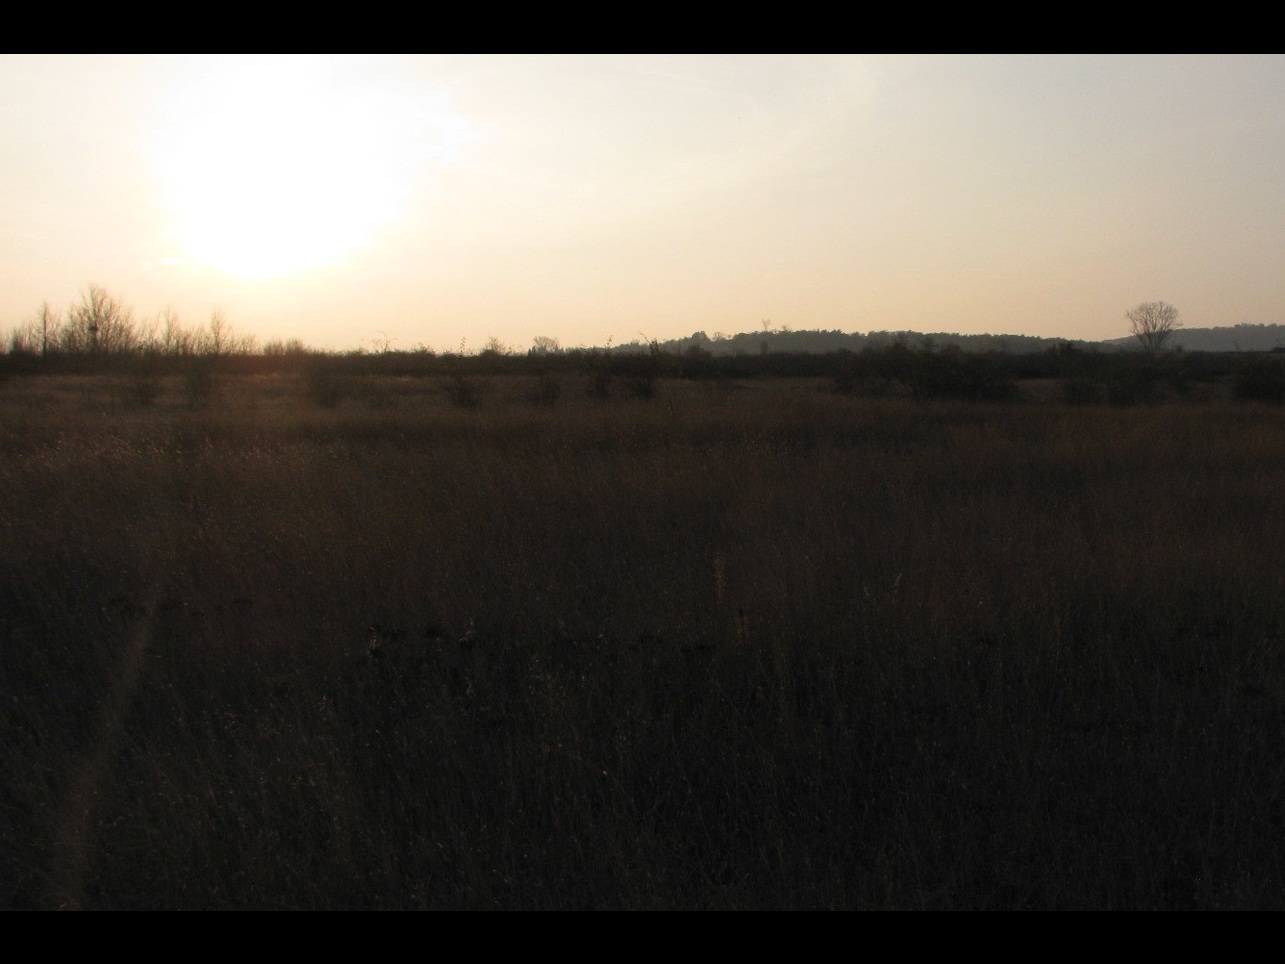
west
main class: Grassland
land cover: Grassland without tree/shrub cover
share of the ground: > 75 %
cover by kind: herbaceous plants 100 %
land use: Agriculture (excluding fallow land and kitchen gardens)
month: December
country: BG
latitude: 42.2645
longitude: 24.2402
